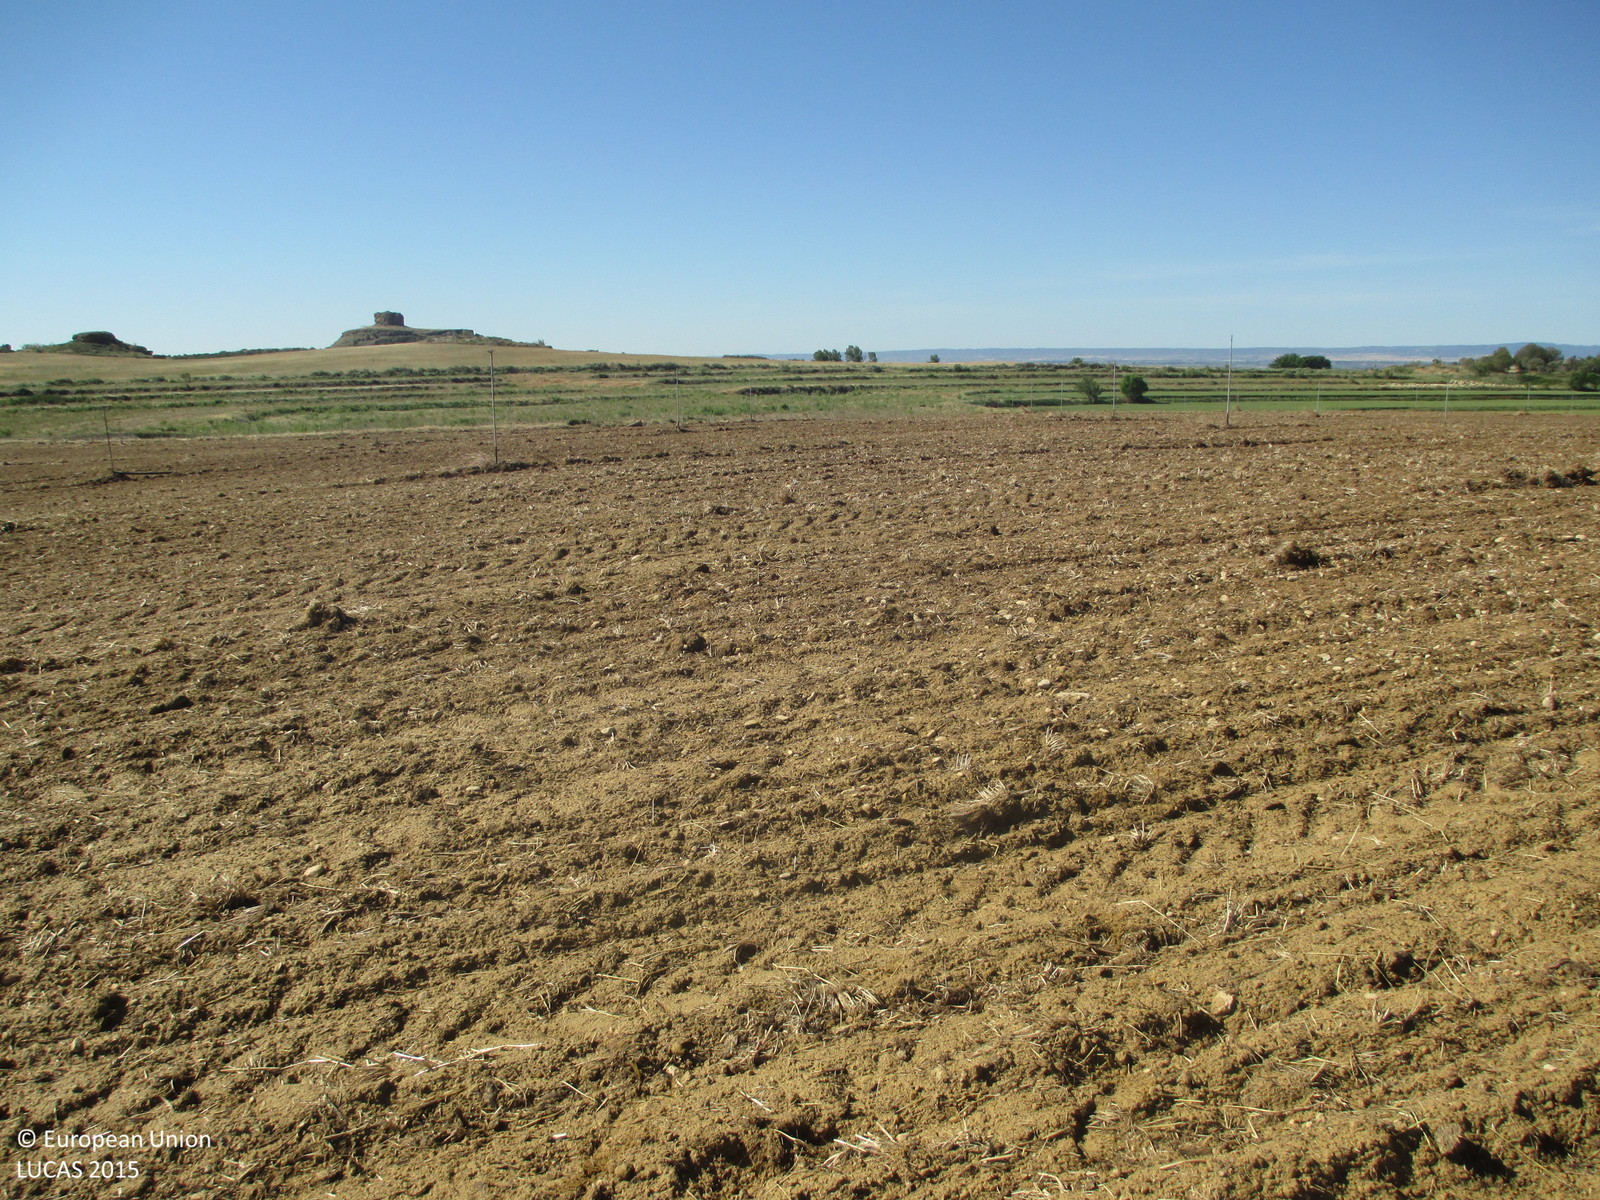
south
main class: Cropland
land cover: Maize
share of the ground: < 10 %
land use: Agriculture (excluding fallow land and kitchen gardens)
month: May
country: ES
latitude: 41.9008
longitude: -0.2049
